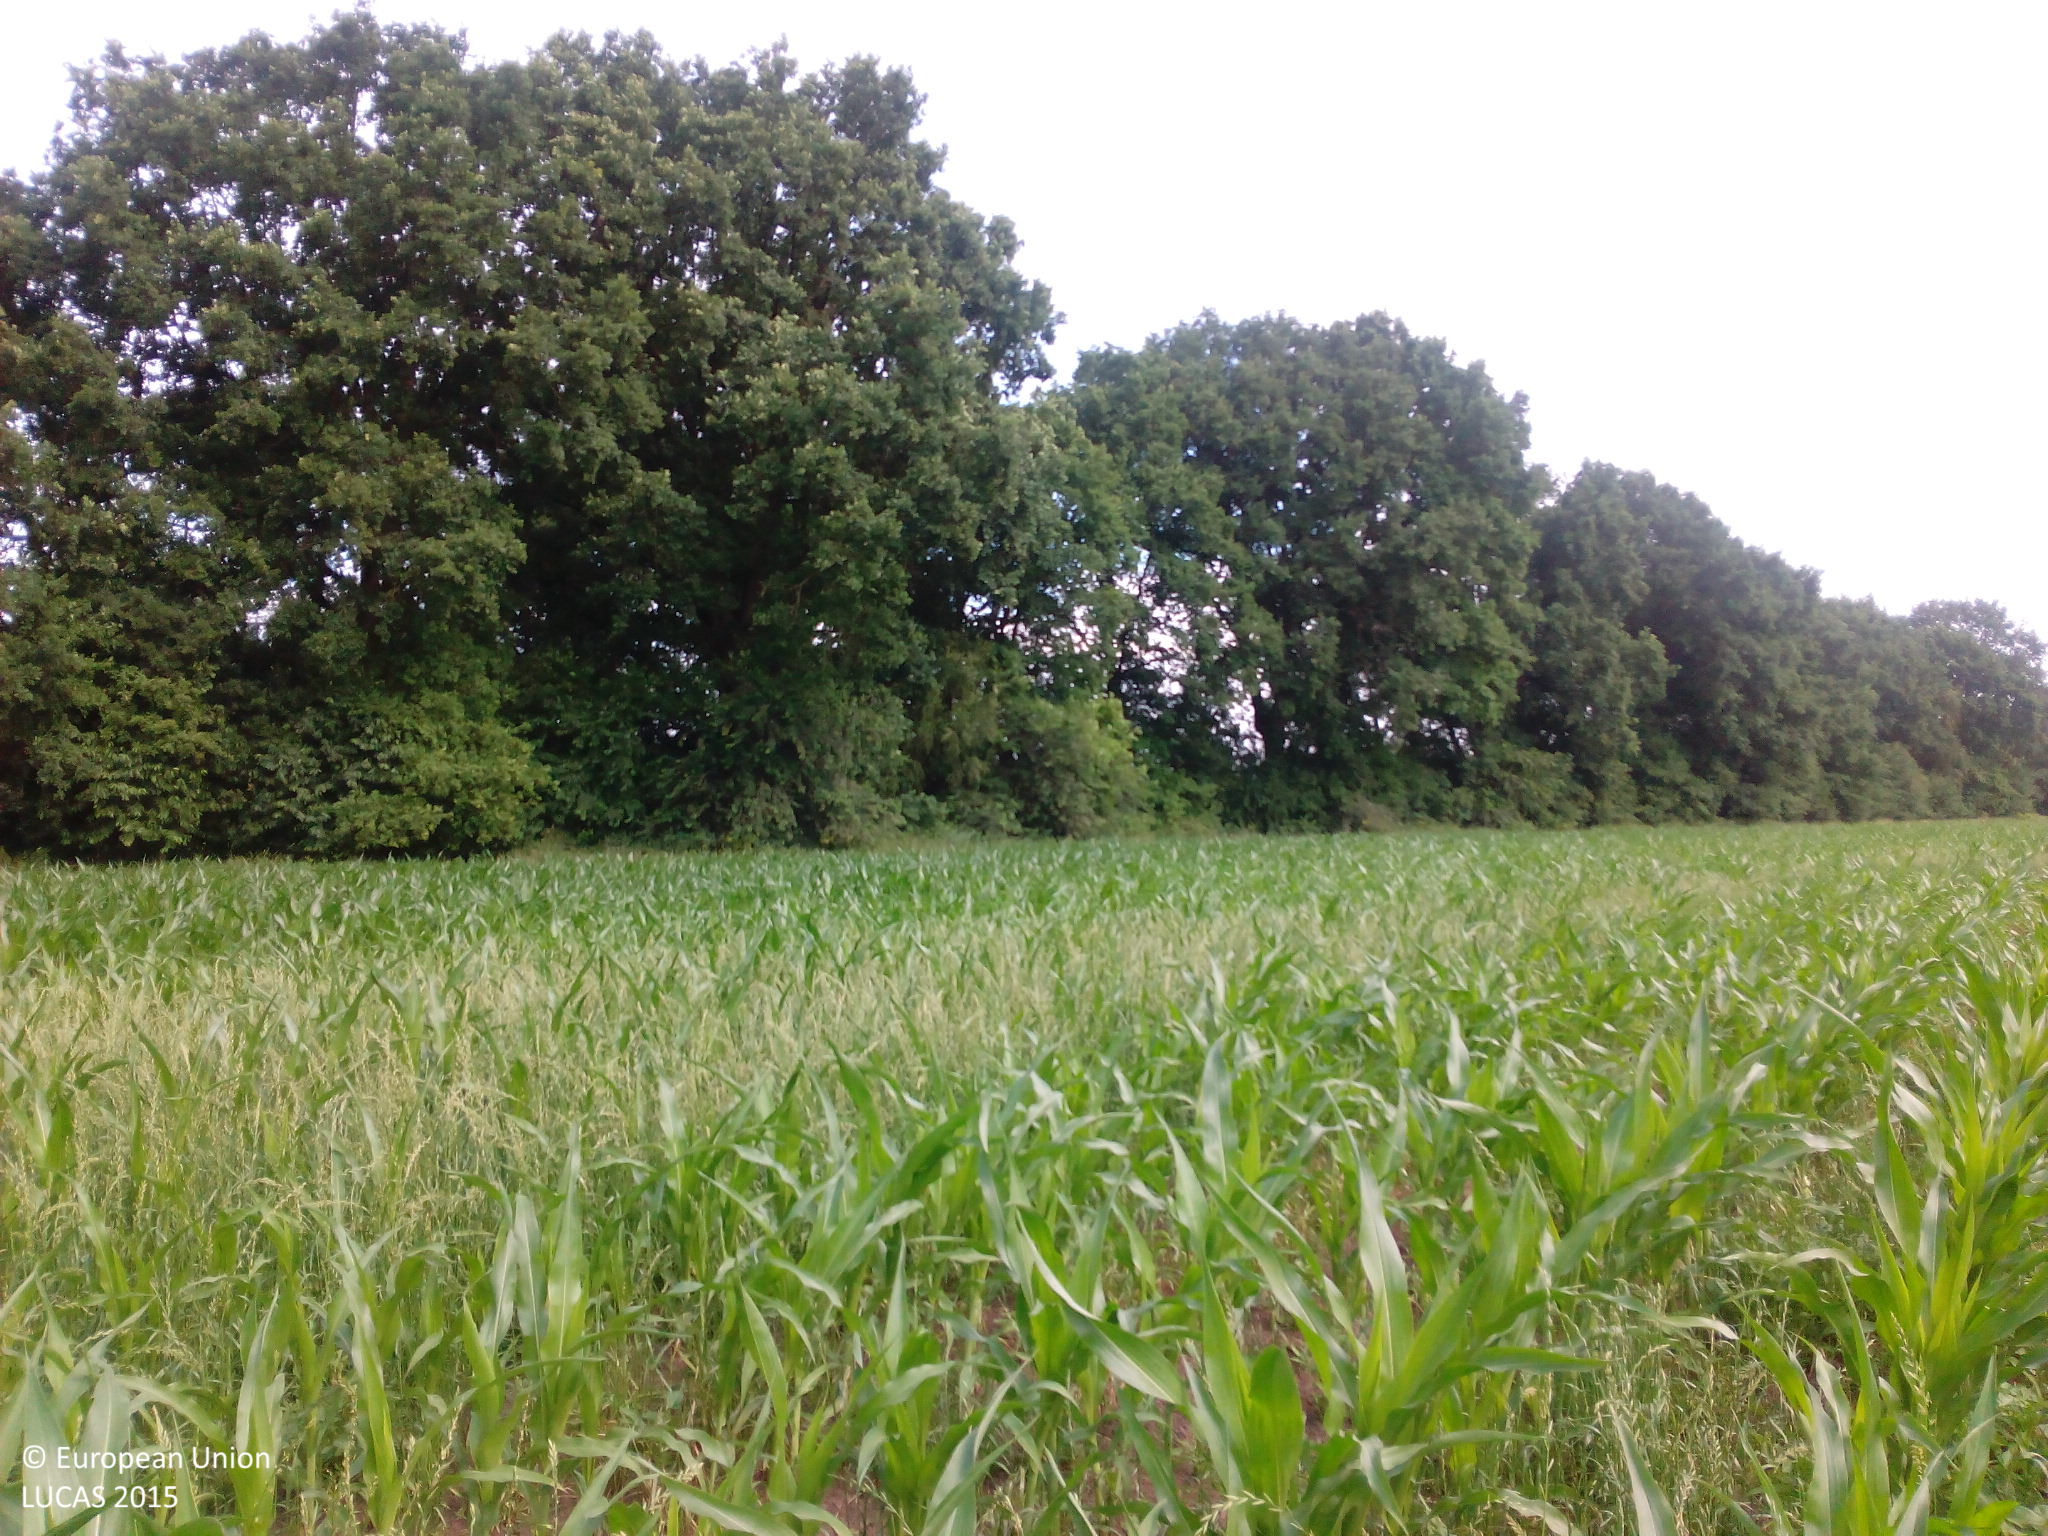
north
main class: Cropland
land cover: Maize
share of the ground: > 75 %
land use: Agriculture (excluding fallow land and kitchen gardens)
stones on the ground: < 10 %
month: July
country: DE
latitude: 52.7256
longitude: 7.3500
